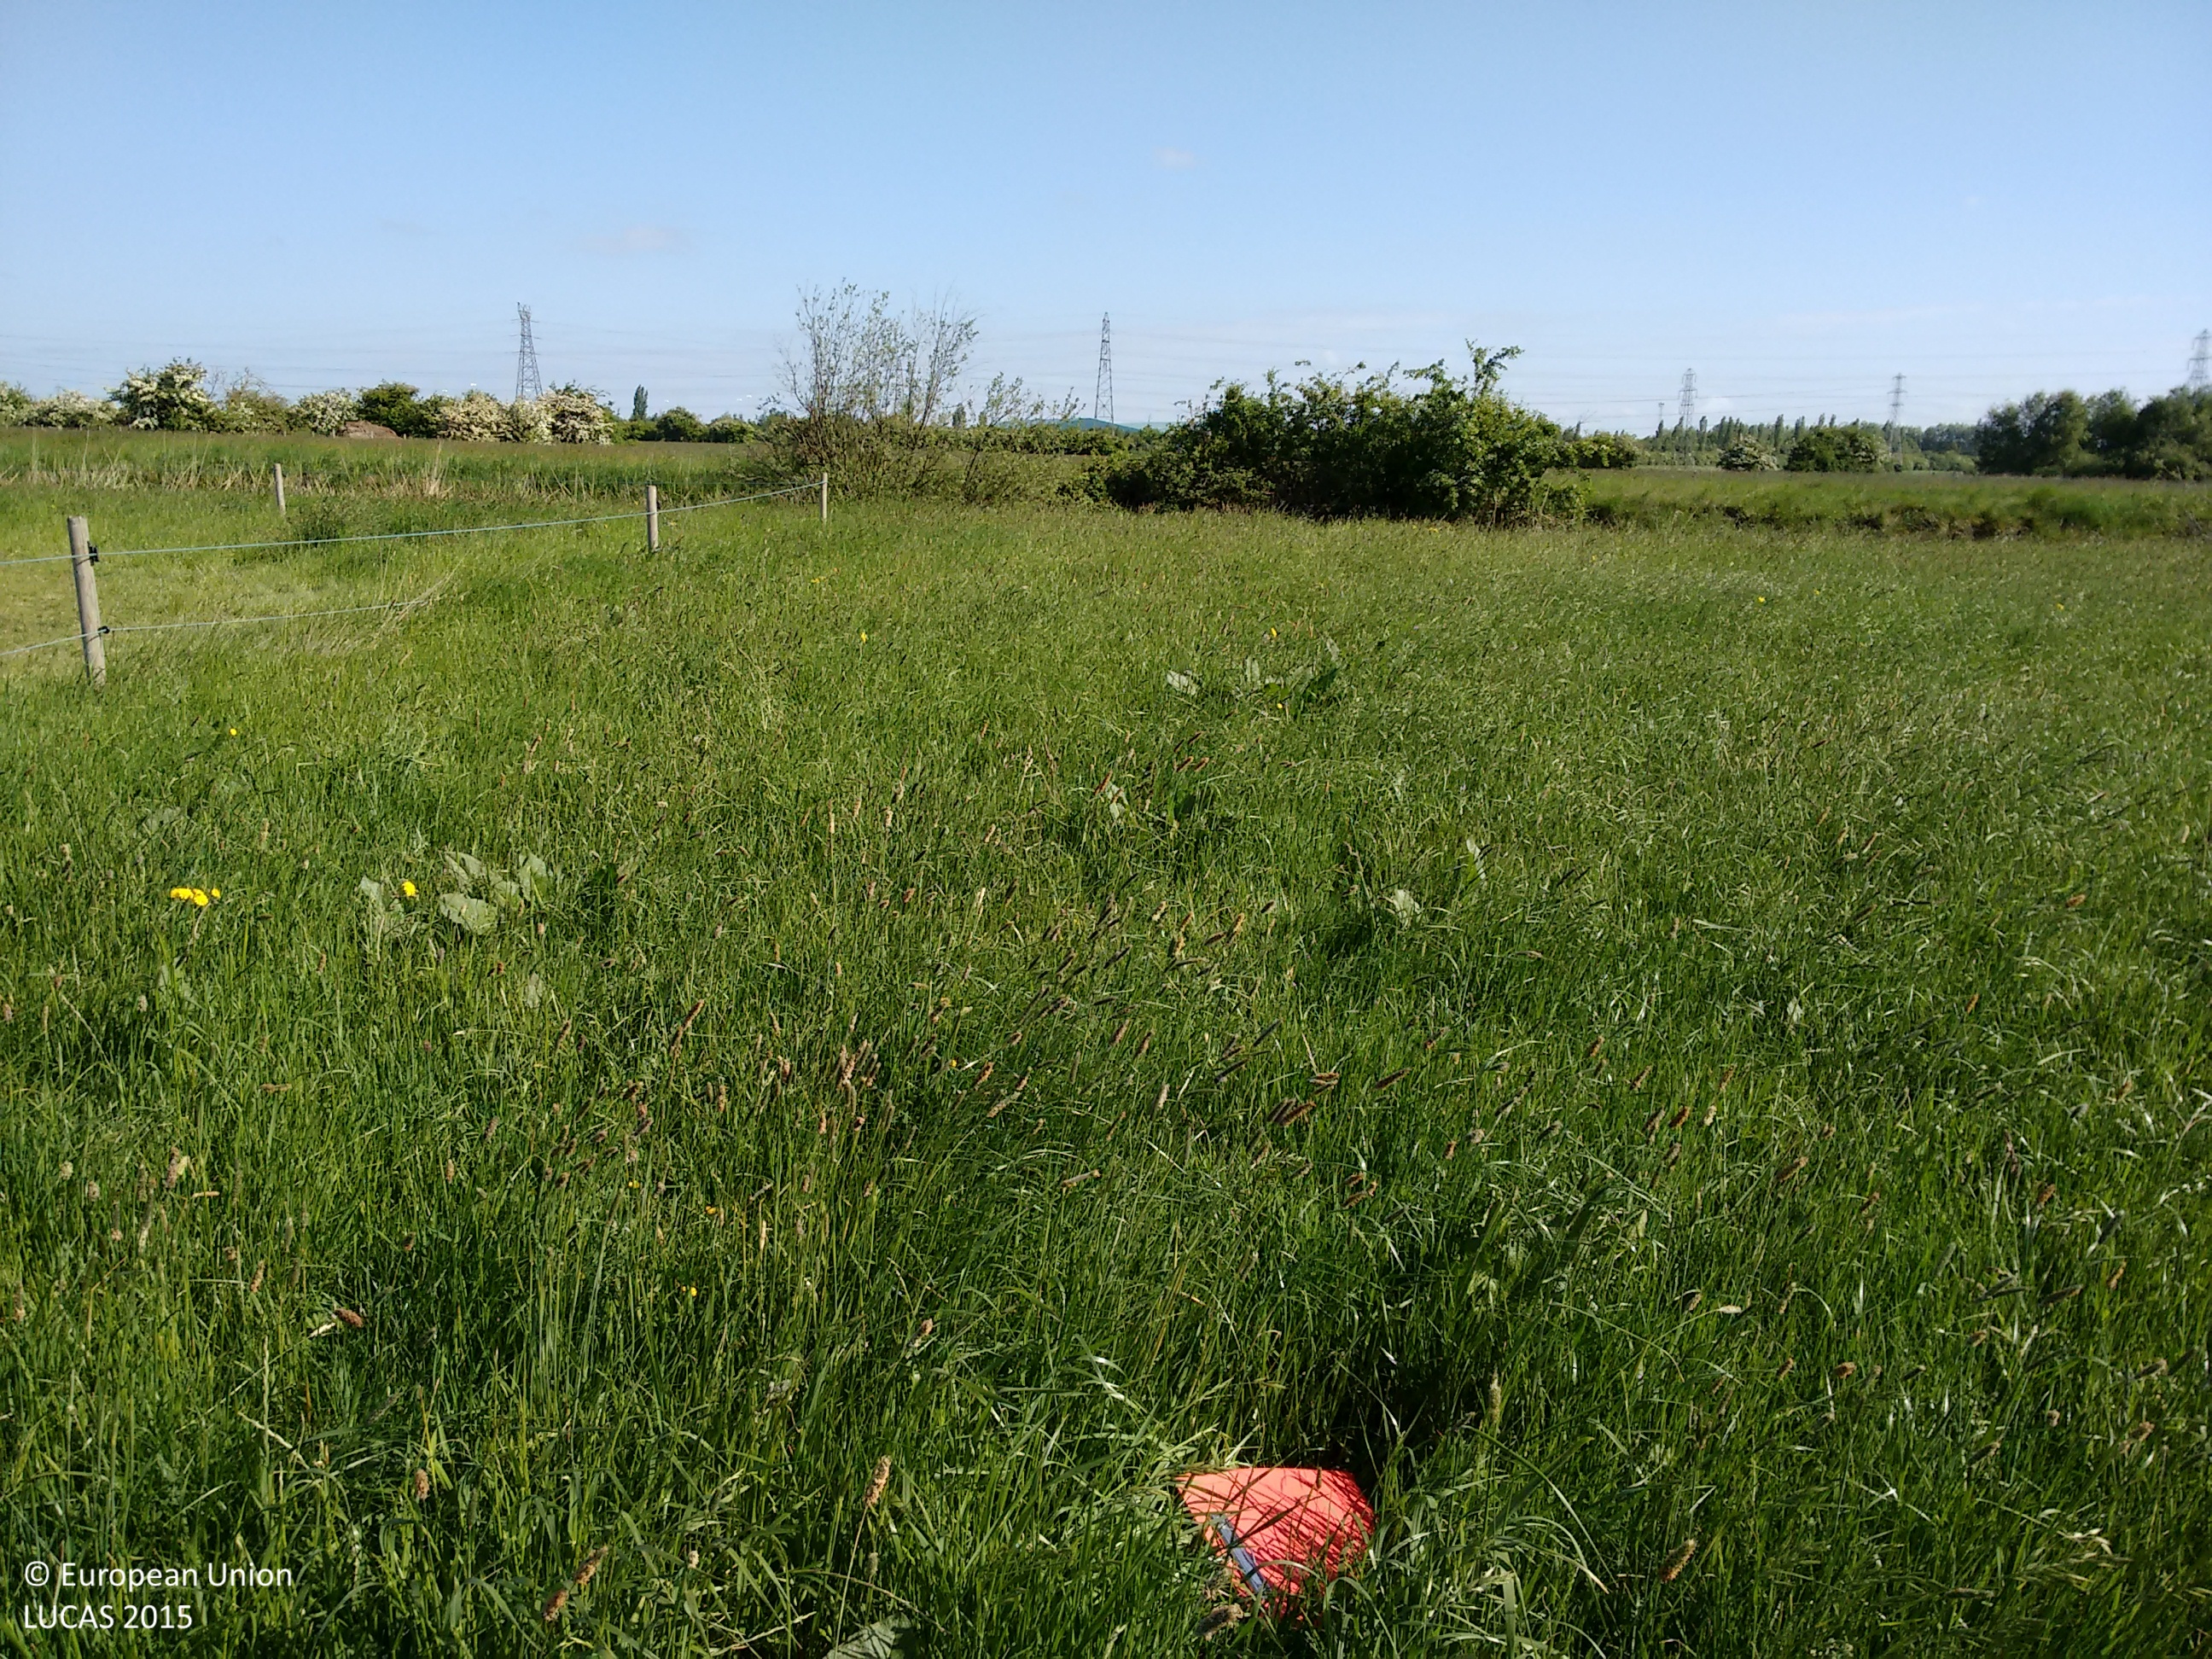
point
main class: Grassland
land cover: Grassland without tree/shrub cover
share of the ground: > 75 %
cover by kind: herbaceous plants 100 %
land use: Agriculture (excluding fallow land and kitchen gardens)
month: May
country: GB
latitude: 53.5957
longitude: -0.7222
